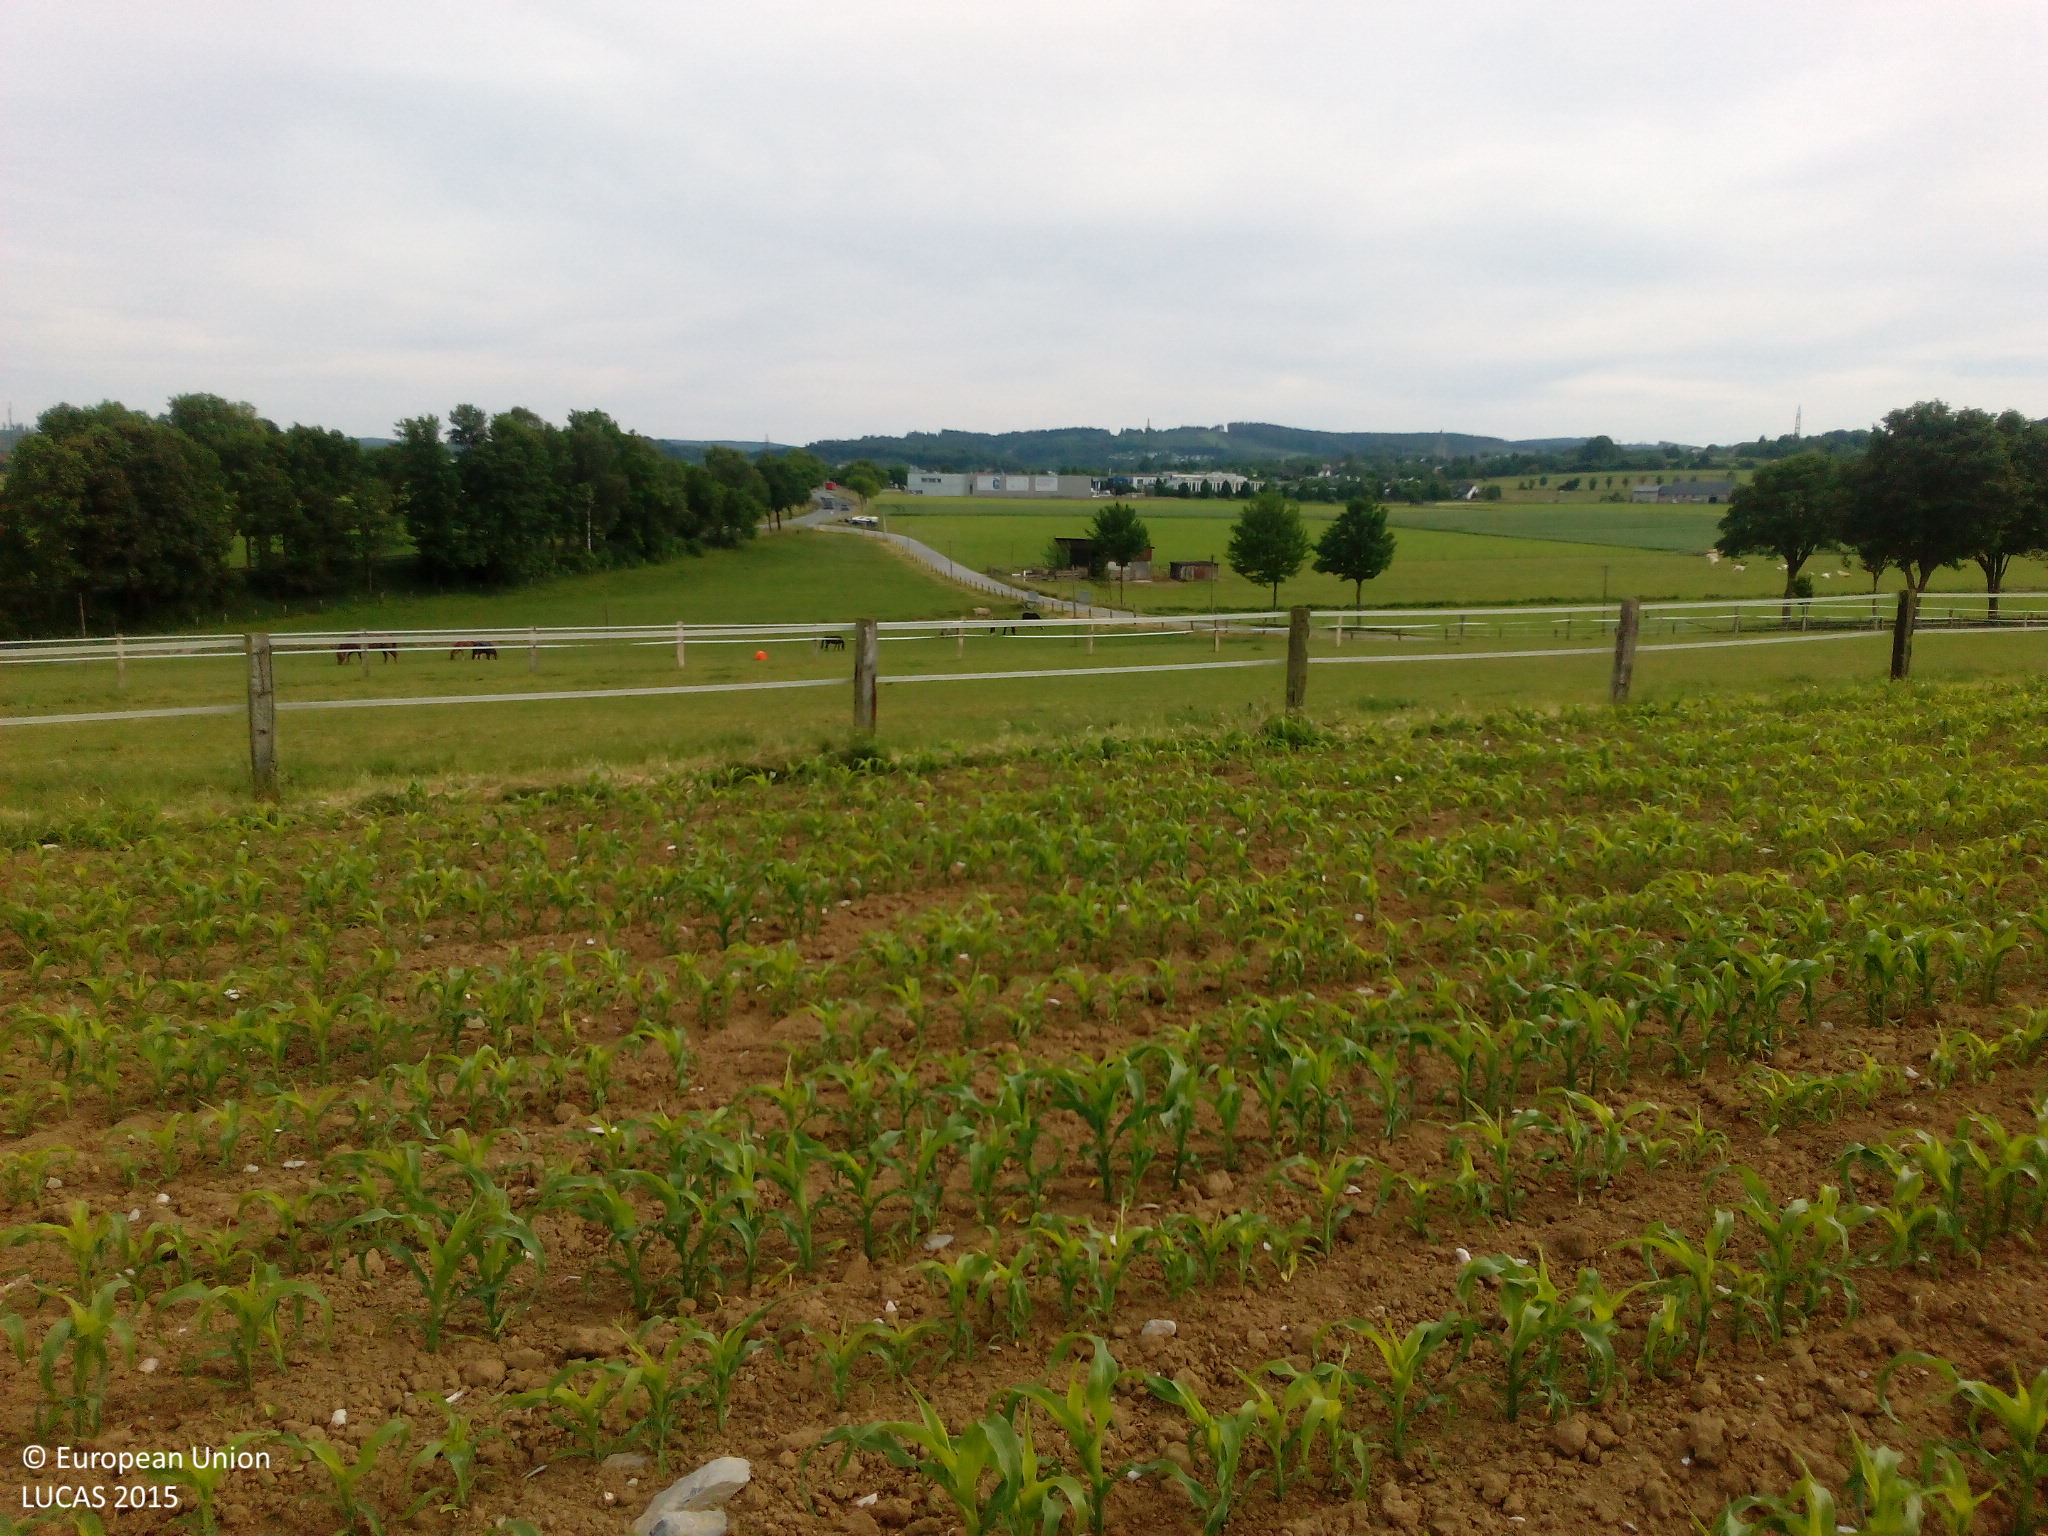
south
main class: Cropland
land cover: Maize
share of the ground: 25 - 50 %
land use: Agriculture (excluding fallow land and kitchen gardens)
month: June
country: DE
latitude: 51.4161
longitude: 8.5768
